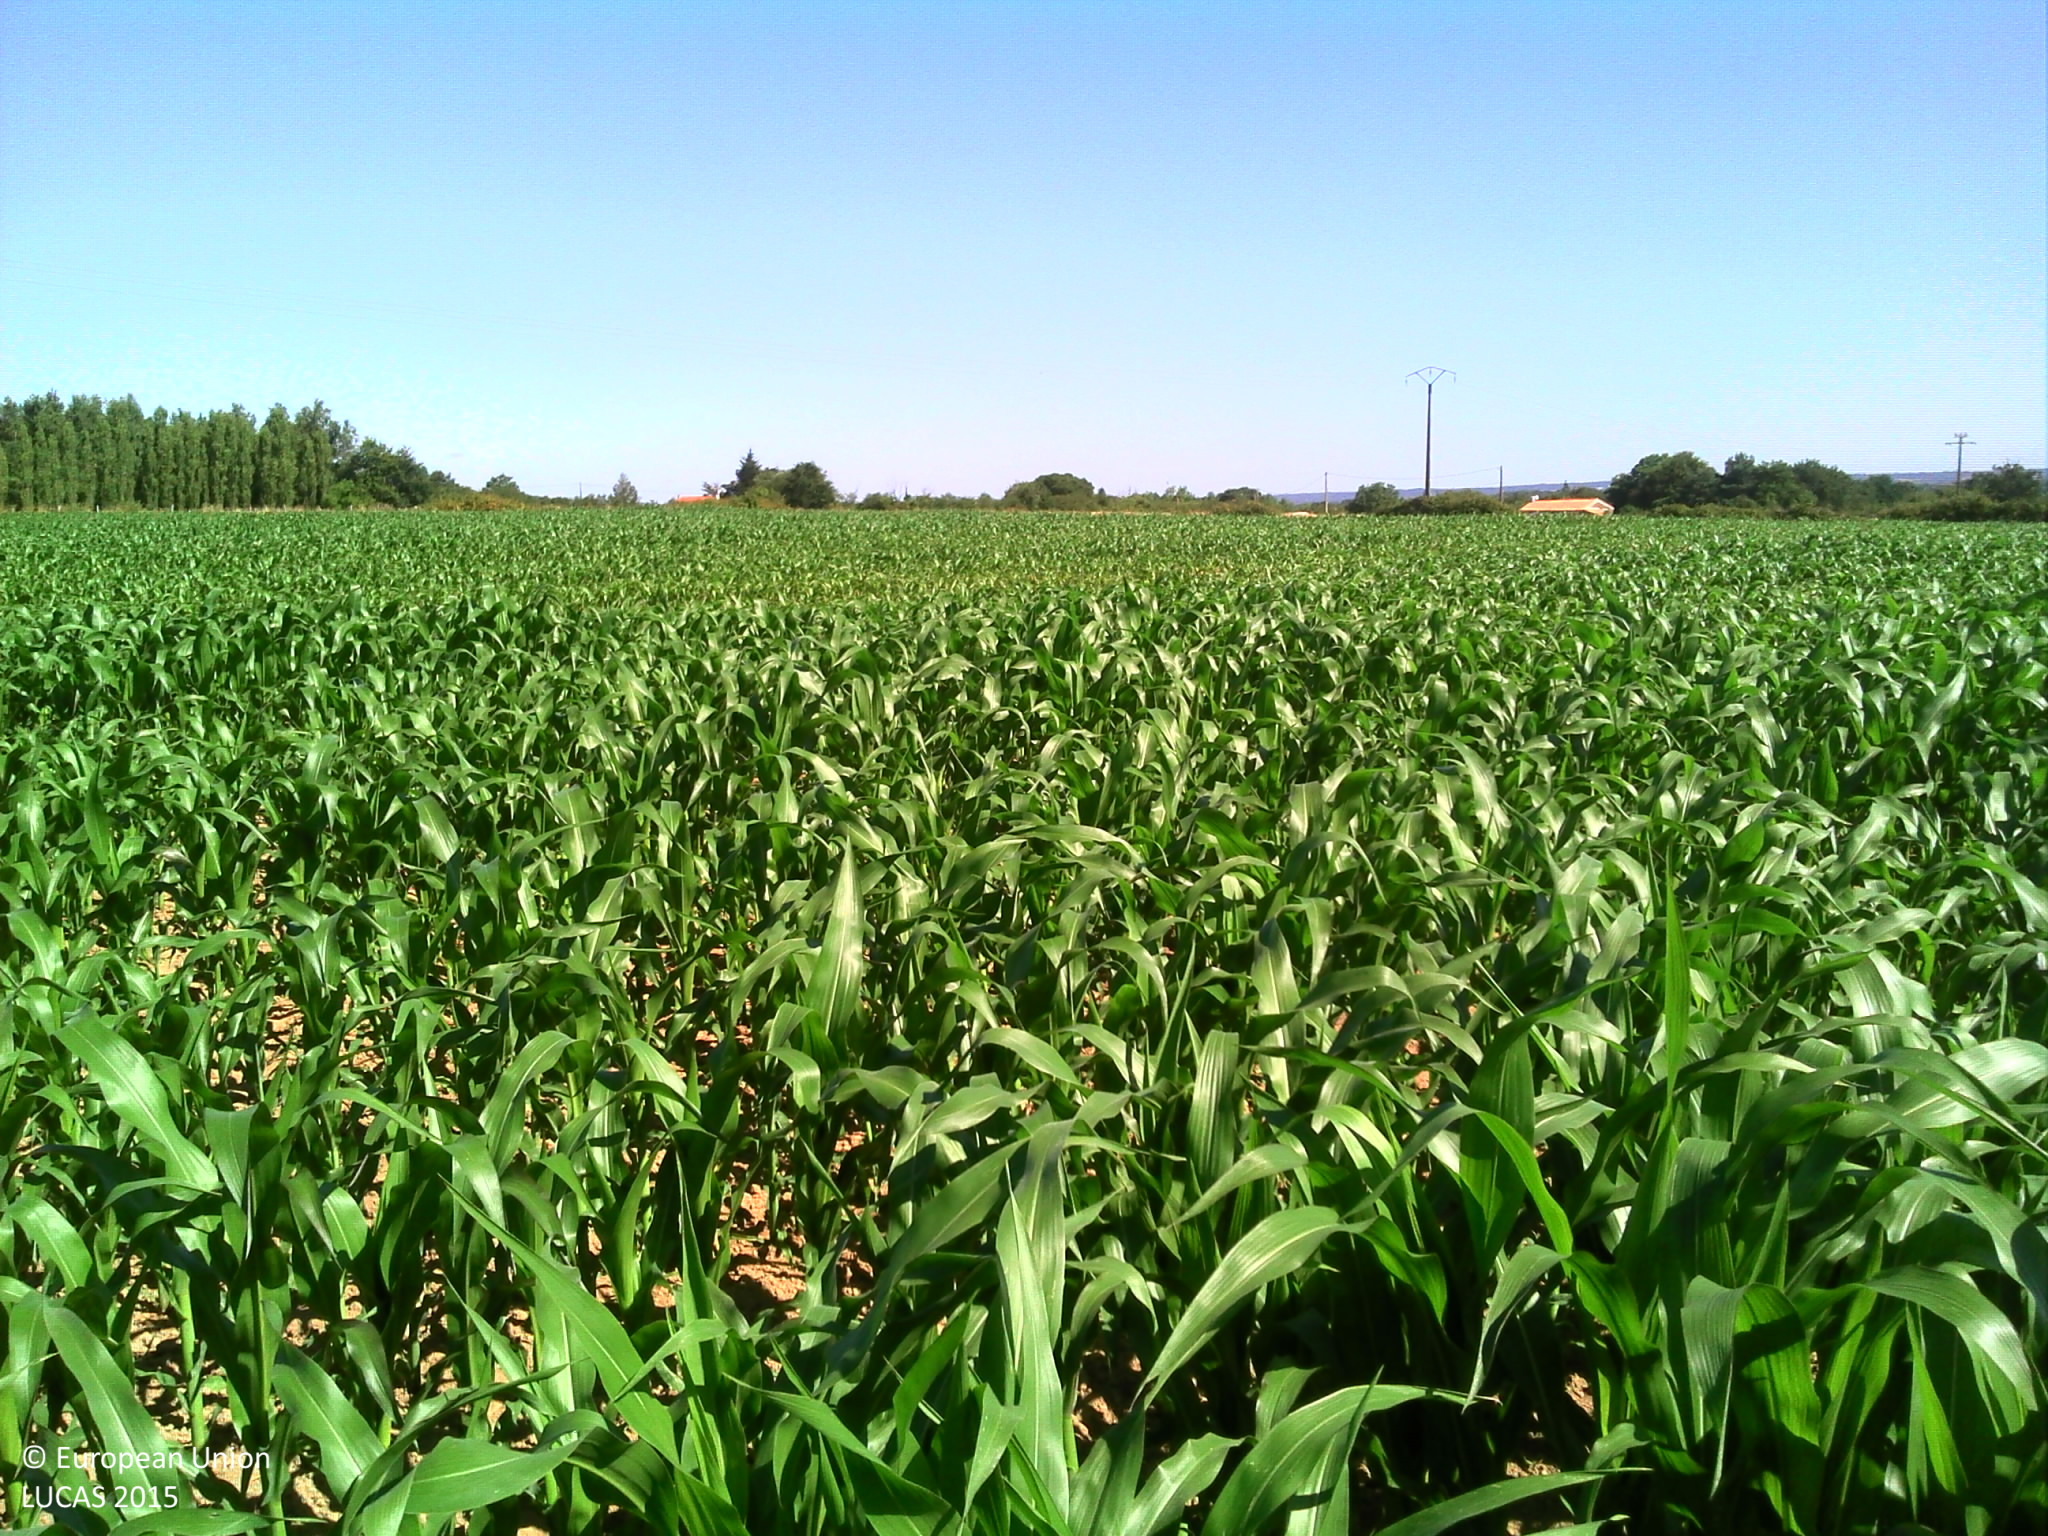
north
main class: Cropland
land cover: Maize
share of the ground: 50 - 75 %
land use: Agriculture (excluding fallow land and kitchen gardens)
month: July
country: FR
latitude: 47.1513
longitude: -1.7958
